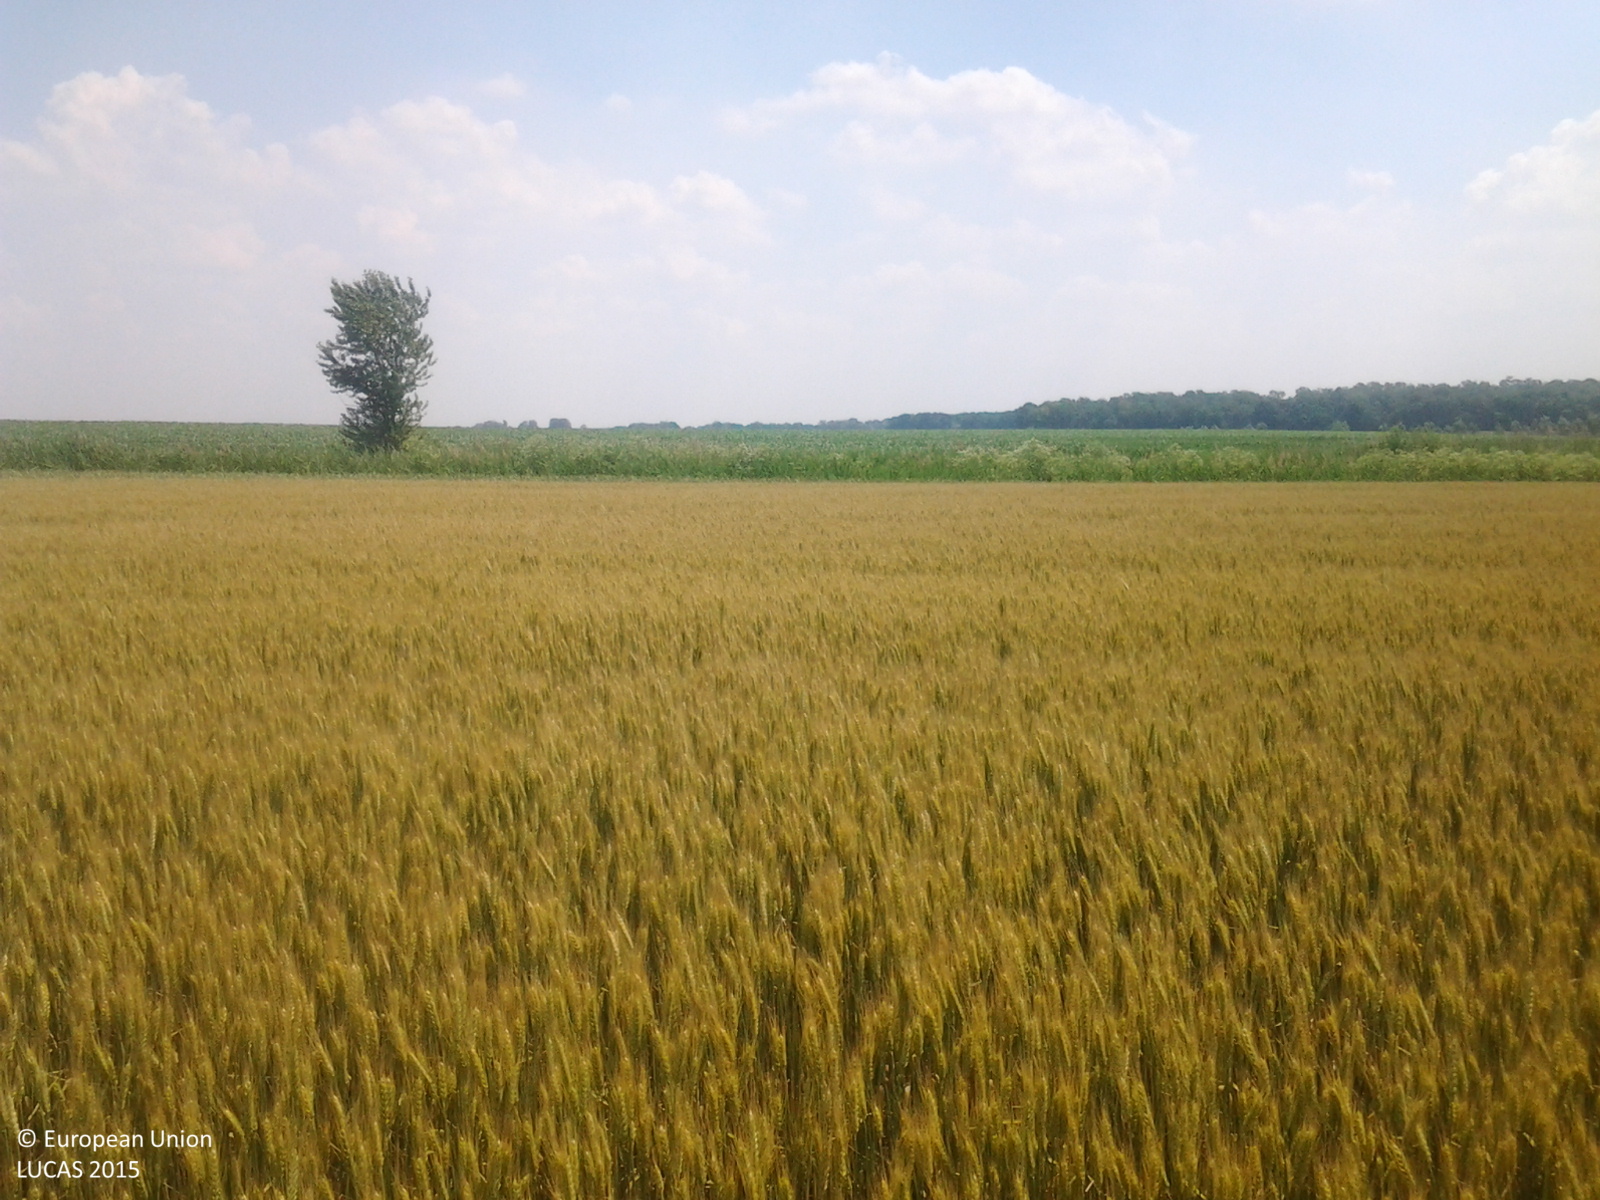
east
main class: Cropland
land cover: Triticale
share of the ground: > 75 %
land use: Agriculture (excluding fallow land and kitchen gardens)
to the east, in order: Triticale; Grass margins; Inland marshes; Inland fresh running water; Inland marshes; Grass margins; Tracks; Grass margins; Maize
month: June
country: HU
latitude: 46.6380
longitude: 19.0412
